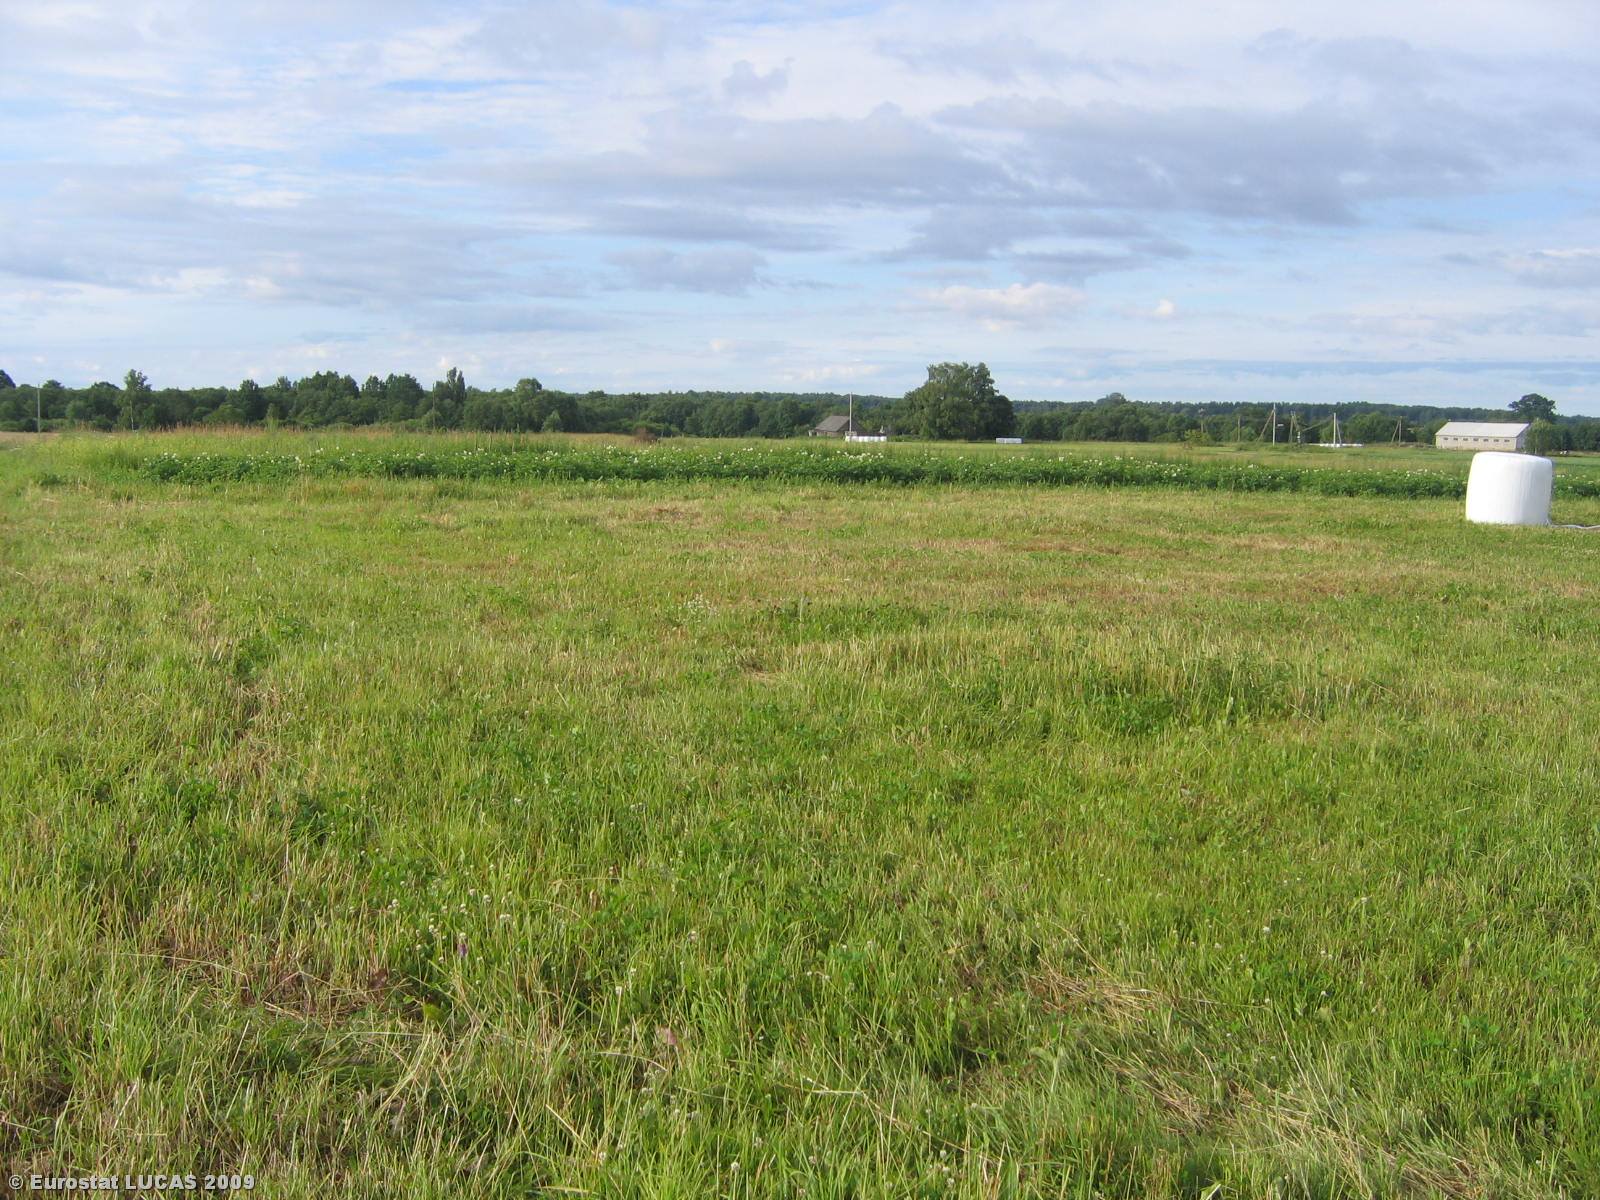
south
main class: Grassland
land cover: Grassland without tree/shrub cover
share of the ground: > 75 %
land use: Agriculture (excluding fallow land and kitchen gardens)
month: July
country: LT
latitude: 55.3324
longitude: 22.7236
